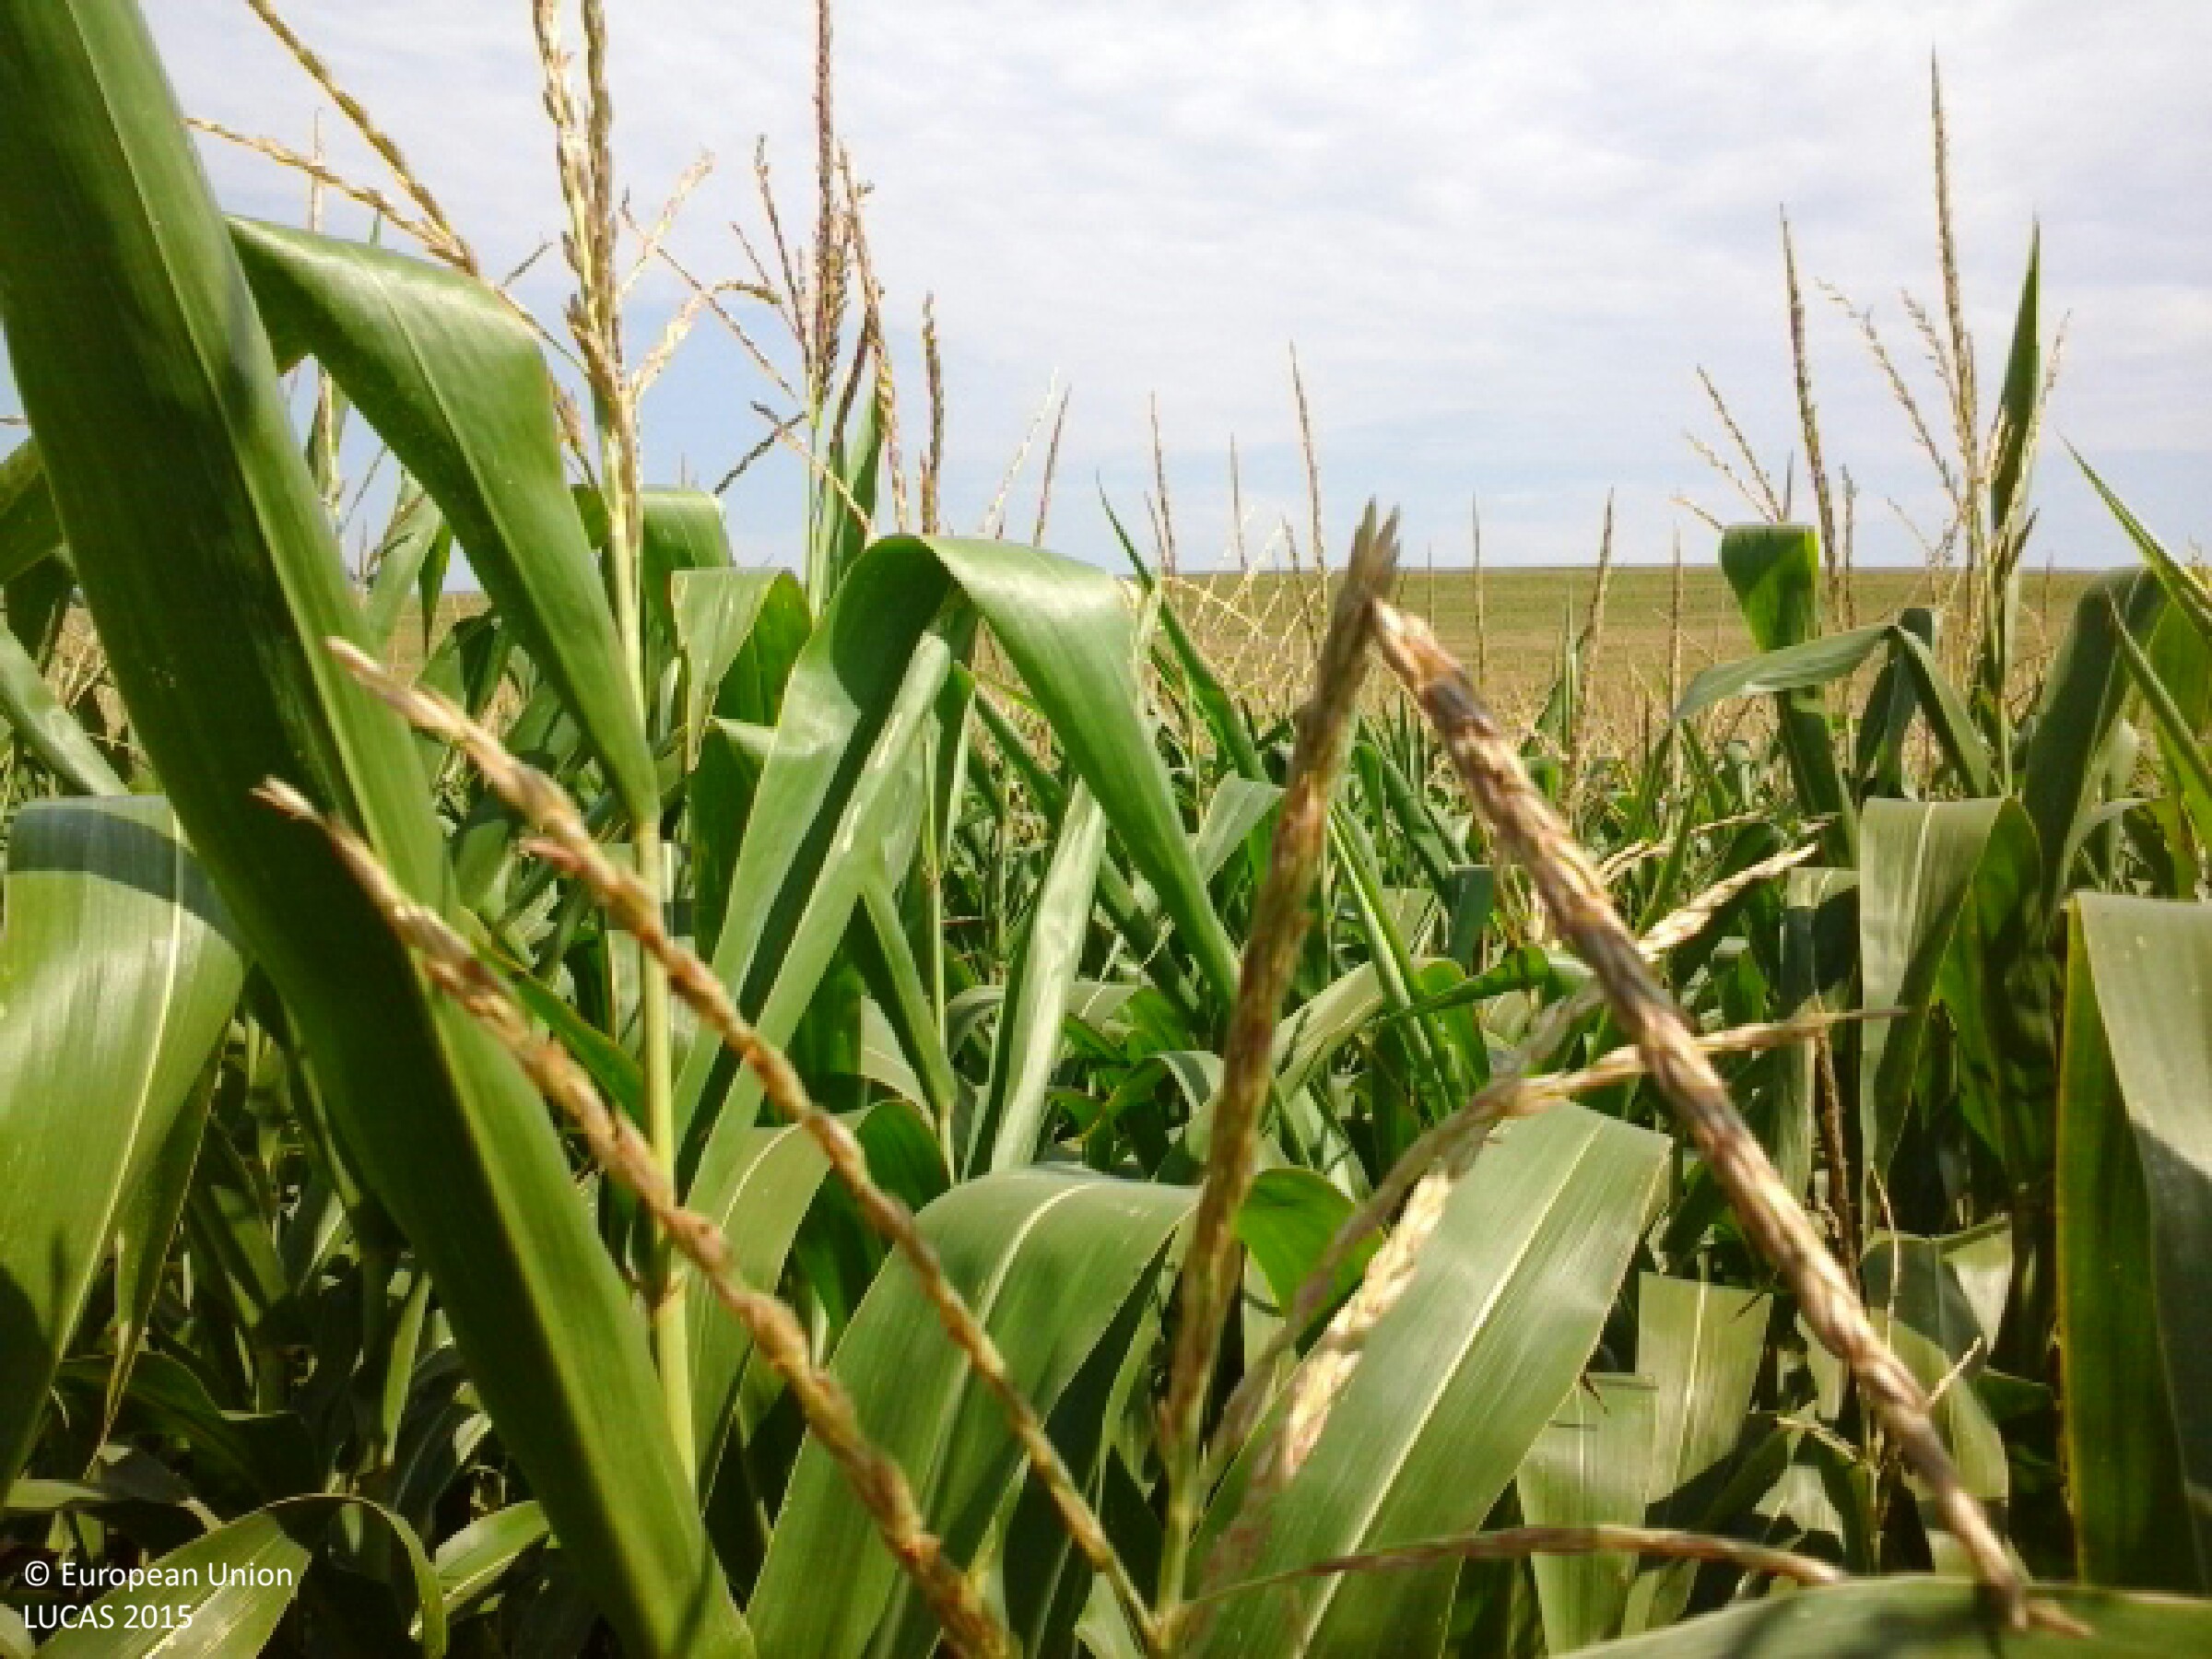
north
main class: Cropland
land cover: Maize
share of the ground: > 75 %
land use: Agriculture (excluding fallow land and kitchen gardens)
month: August
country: HU
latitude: 47.6022
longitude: 18.5404
